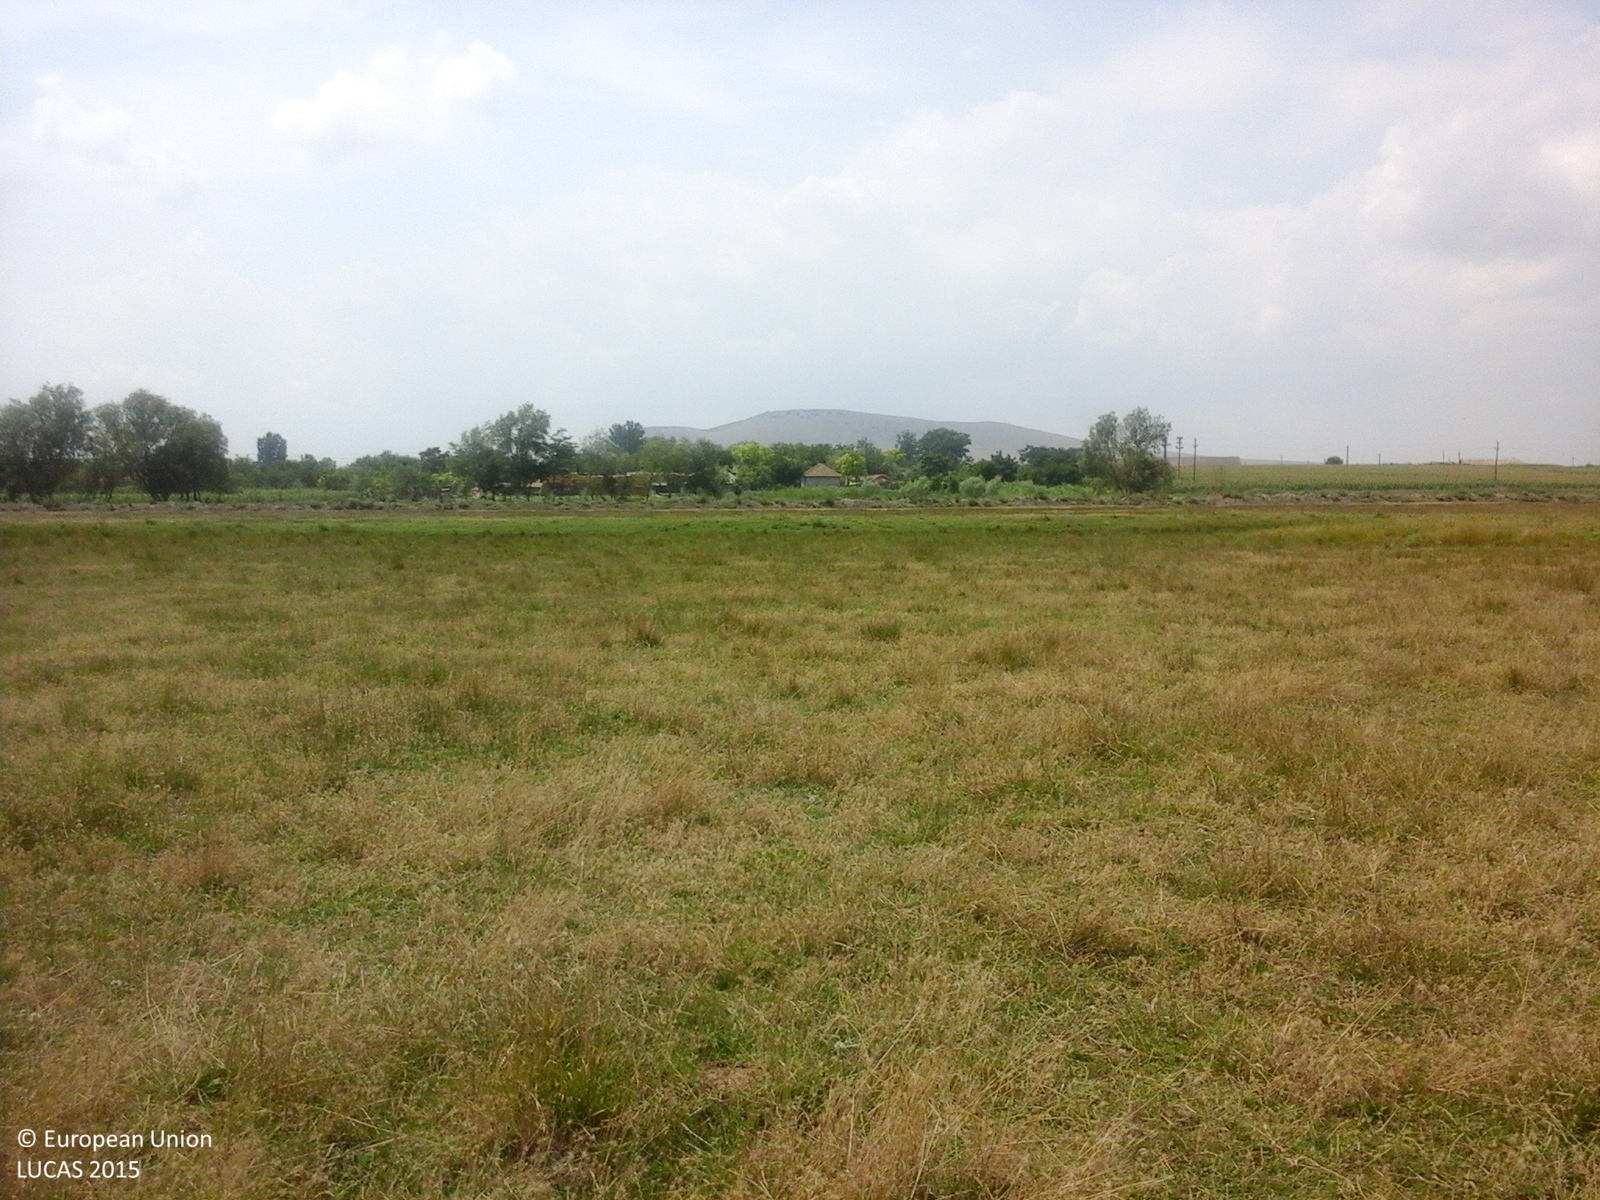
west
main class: Grassland
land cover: Grassland without tree/shrub cover
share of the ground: > 75 %
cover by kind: herbaceous plants 100 %
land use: Agriculture (excluding fallow land and kitchen gardens)
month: July
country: RO
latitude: 45.0062
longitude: 28.7495
